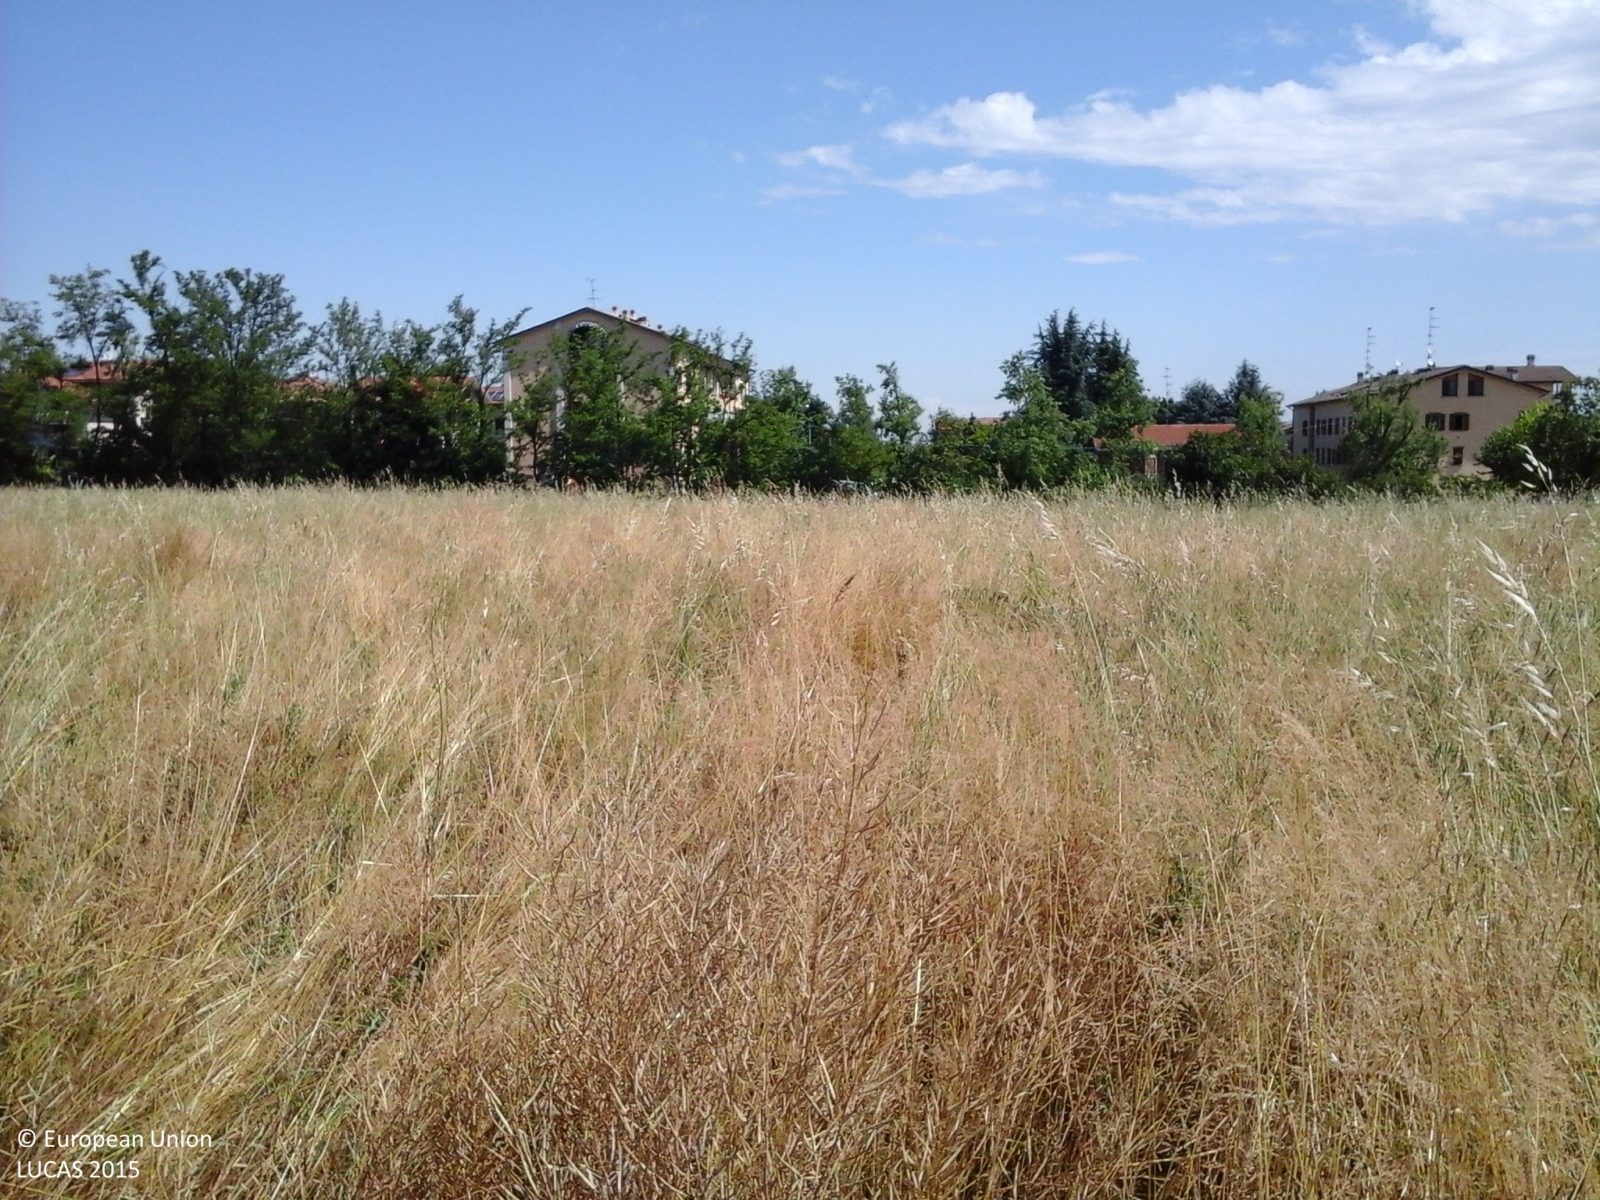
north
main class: Grassland
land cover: Spontaneously vegetated surfaces
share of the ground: > 75 %
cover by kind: herbaceous plants 100 %
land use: Agriculture (excluding fallow land and kitchen gardens)
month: May
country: IT
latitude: 44.6555
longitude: 10.5914
